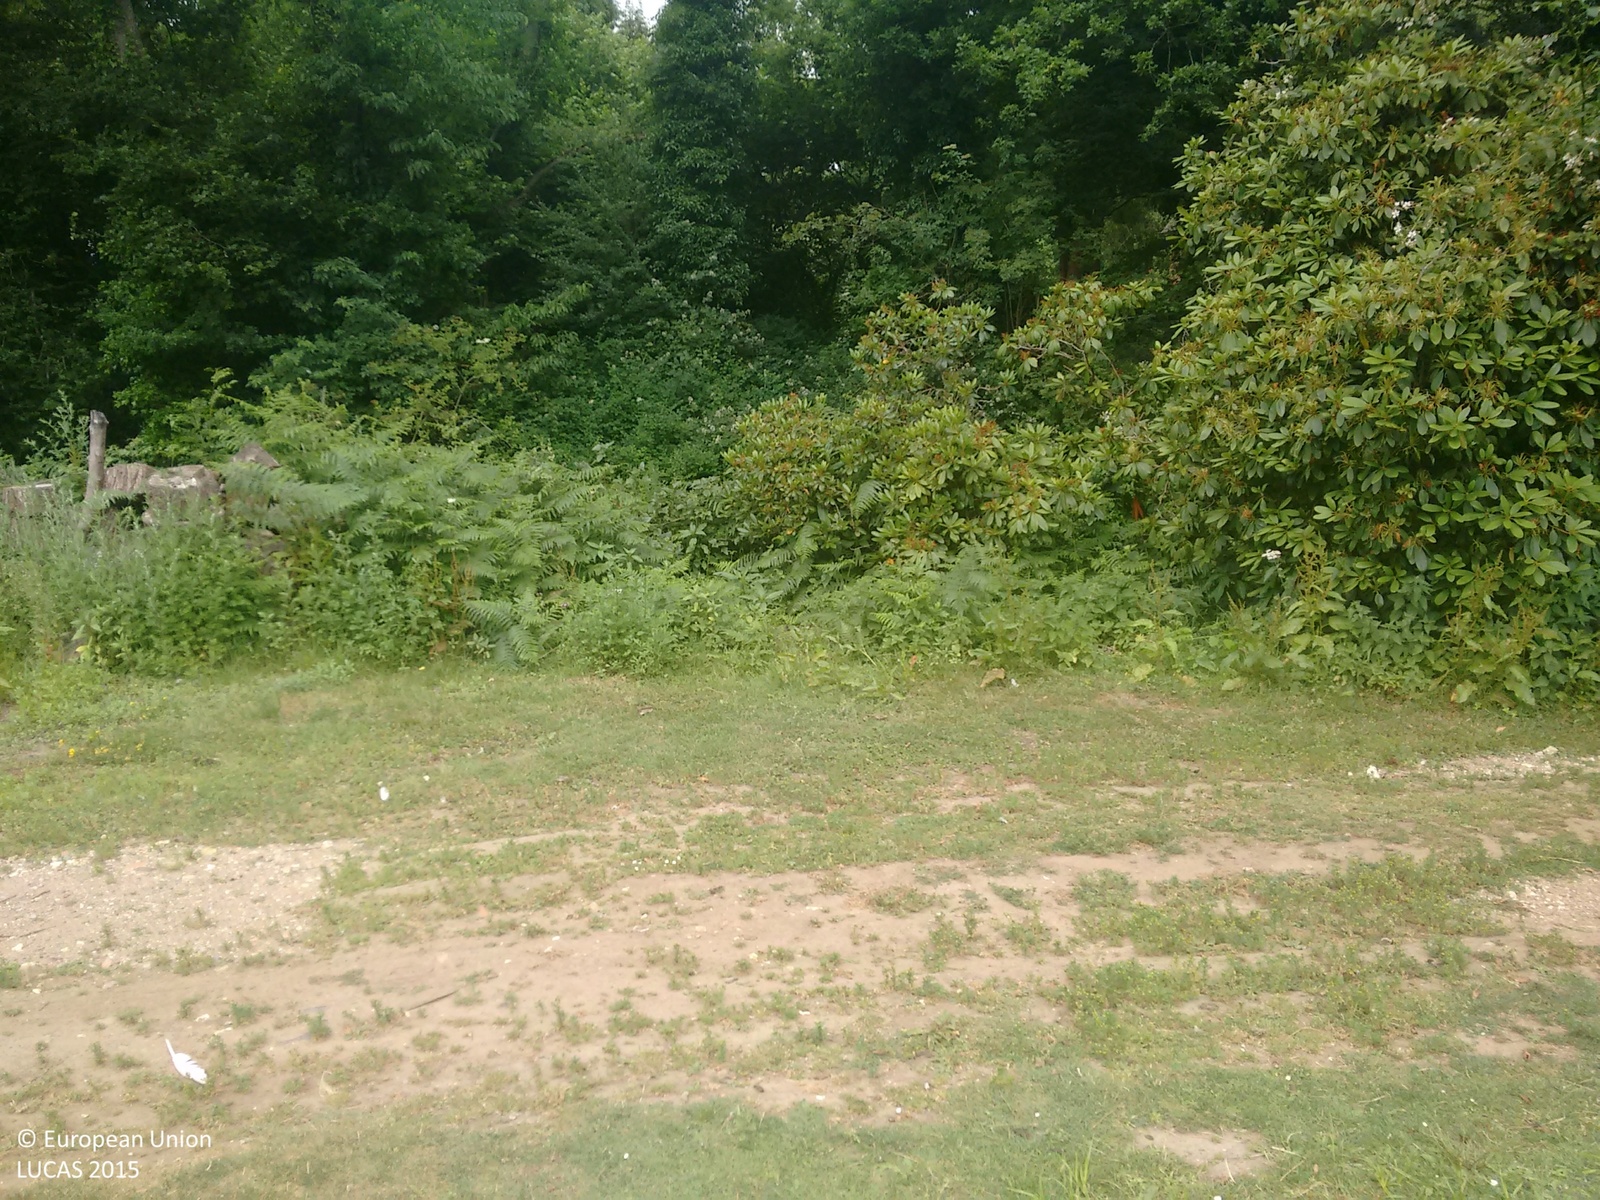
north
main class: Grassland
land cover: Grassland without tree/shrub cover
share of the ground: > 75 %
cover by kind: herbaceous plants 80 %, unconsolidated bare surface 20 %
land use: Sport
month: July
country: GB
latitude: 51.2184
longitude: -0.5333
